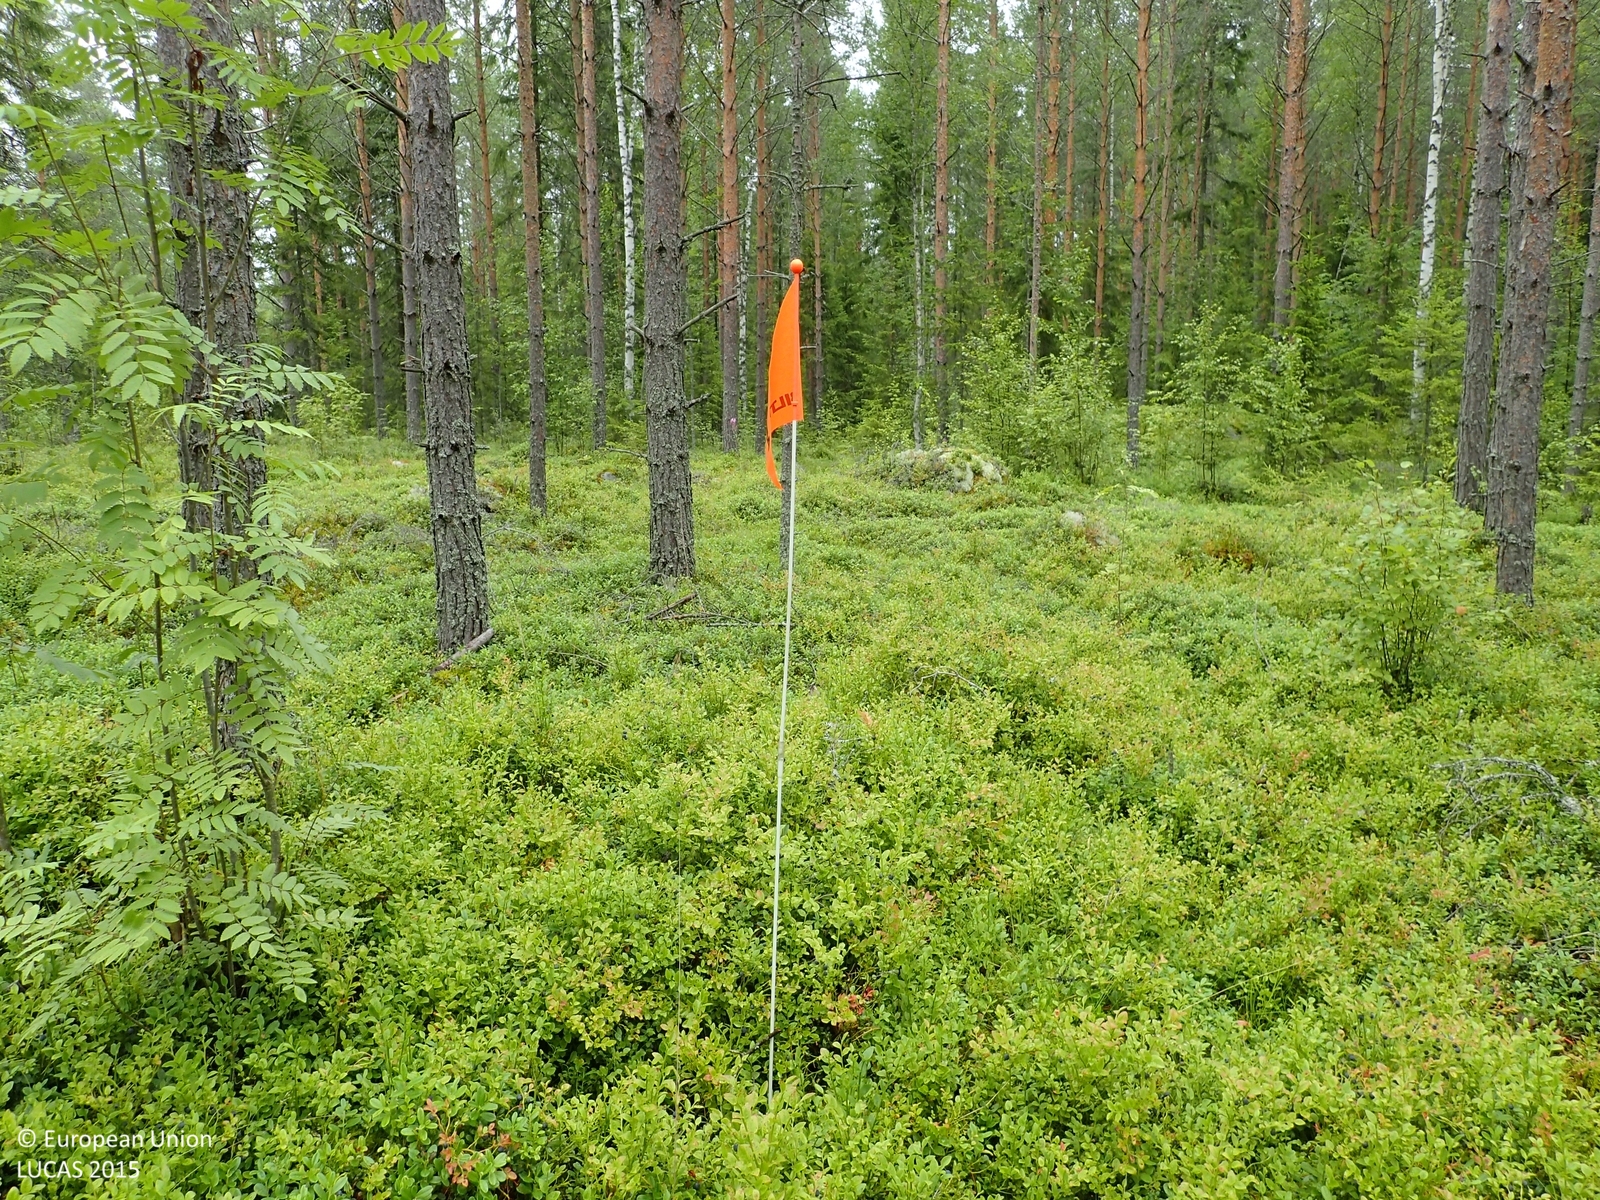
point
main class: Woodland
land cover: Pine dominated coniferous woodland
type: boreal forest
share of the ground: 25 - 50 %
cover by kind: shrubs 60 %, coniferous forest trees 35 %, broadleaved forest trees 5 %
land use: Forestry
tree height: > 5 m
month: July
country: FI
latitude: 62.8183
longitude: 22.7520
